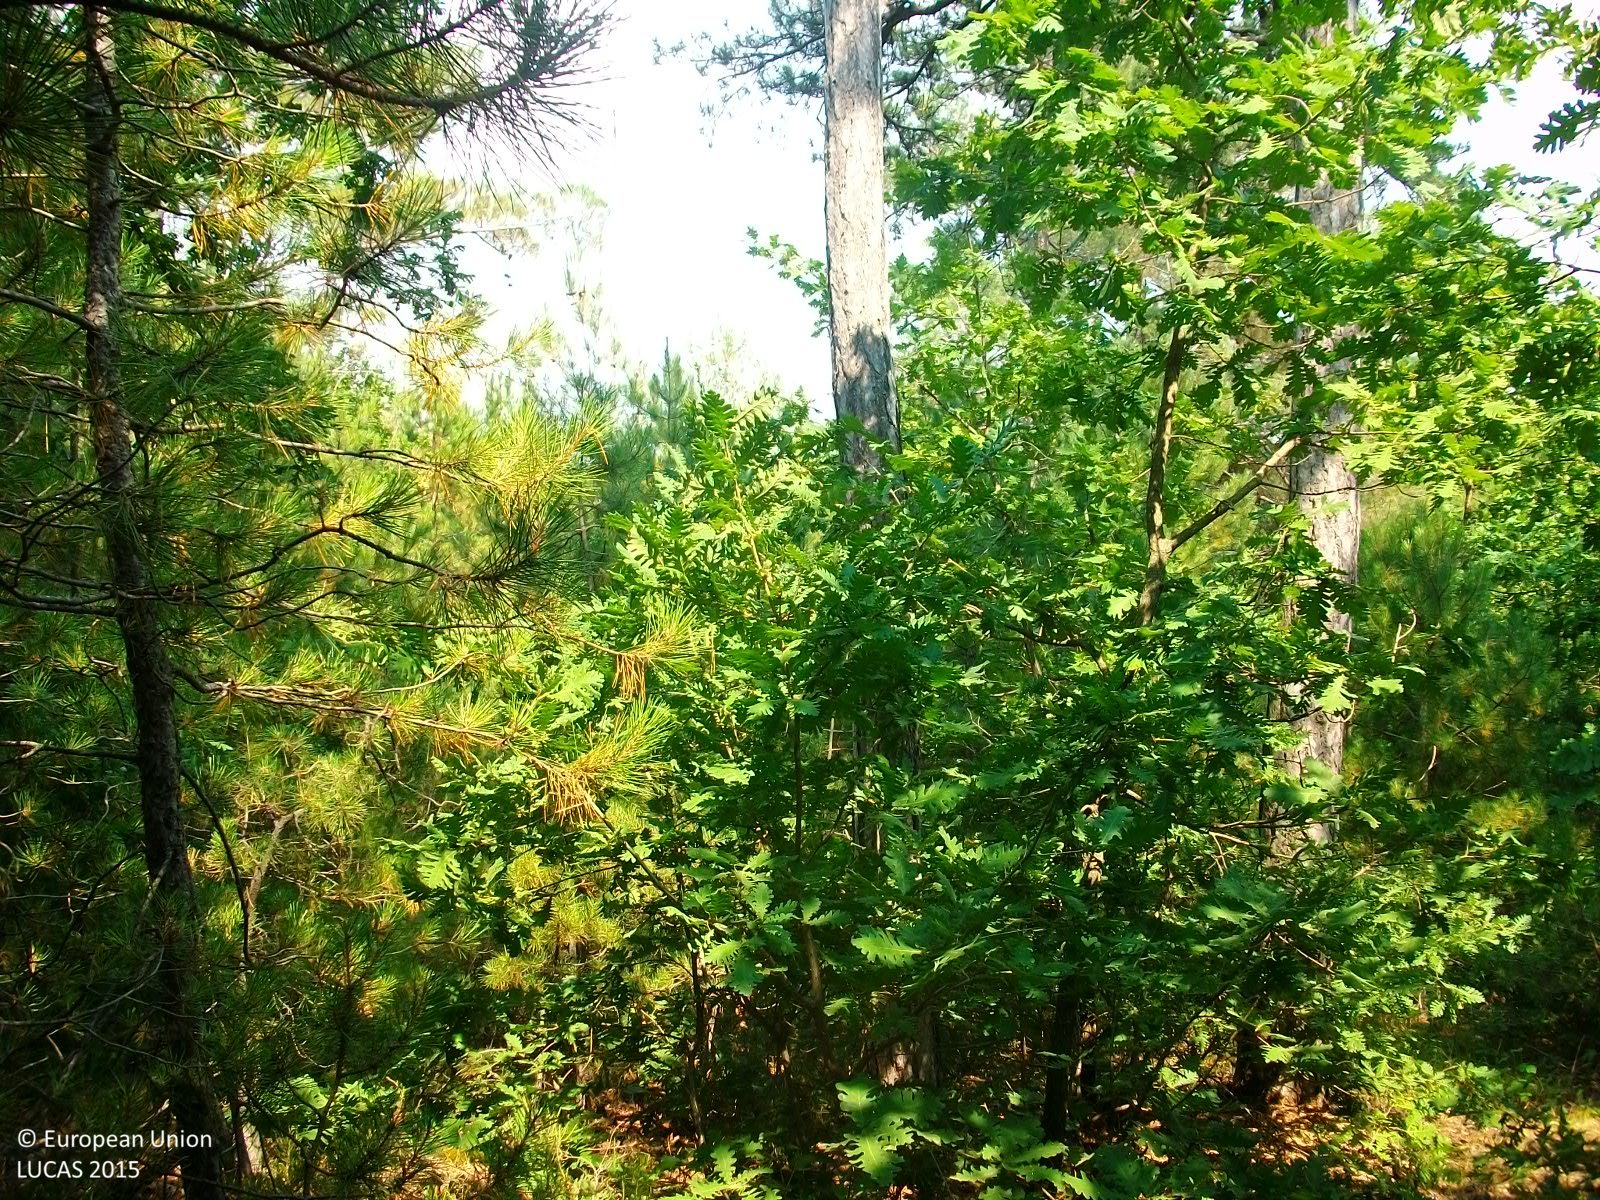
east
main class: Woodland
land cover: Pine dominated mixed woodland
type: coniferous forest of the mediterranean region
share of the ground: 50 - 75 %
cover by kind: coniferous forest trees 60 %, broadleaved forest trees 40 %
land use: Forestry
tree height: > 5 m
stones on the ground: < 10 %
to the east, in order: Pine dominated mixed woodland; Pine dominated coniferous woodland; Pine dominated mixed woodland; Pine dominated coniferous woodland; Paved roads, cycling and walking lanes
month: July
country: GR
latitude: 41.1122
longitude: 26.1299
